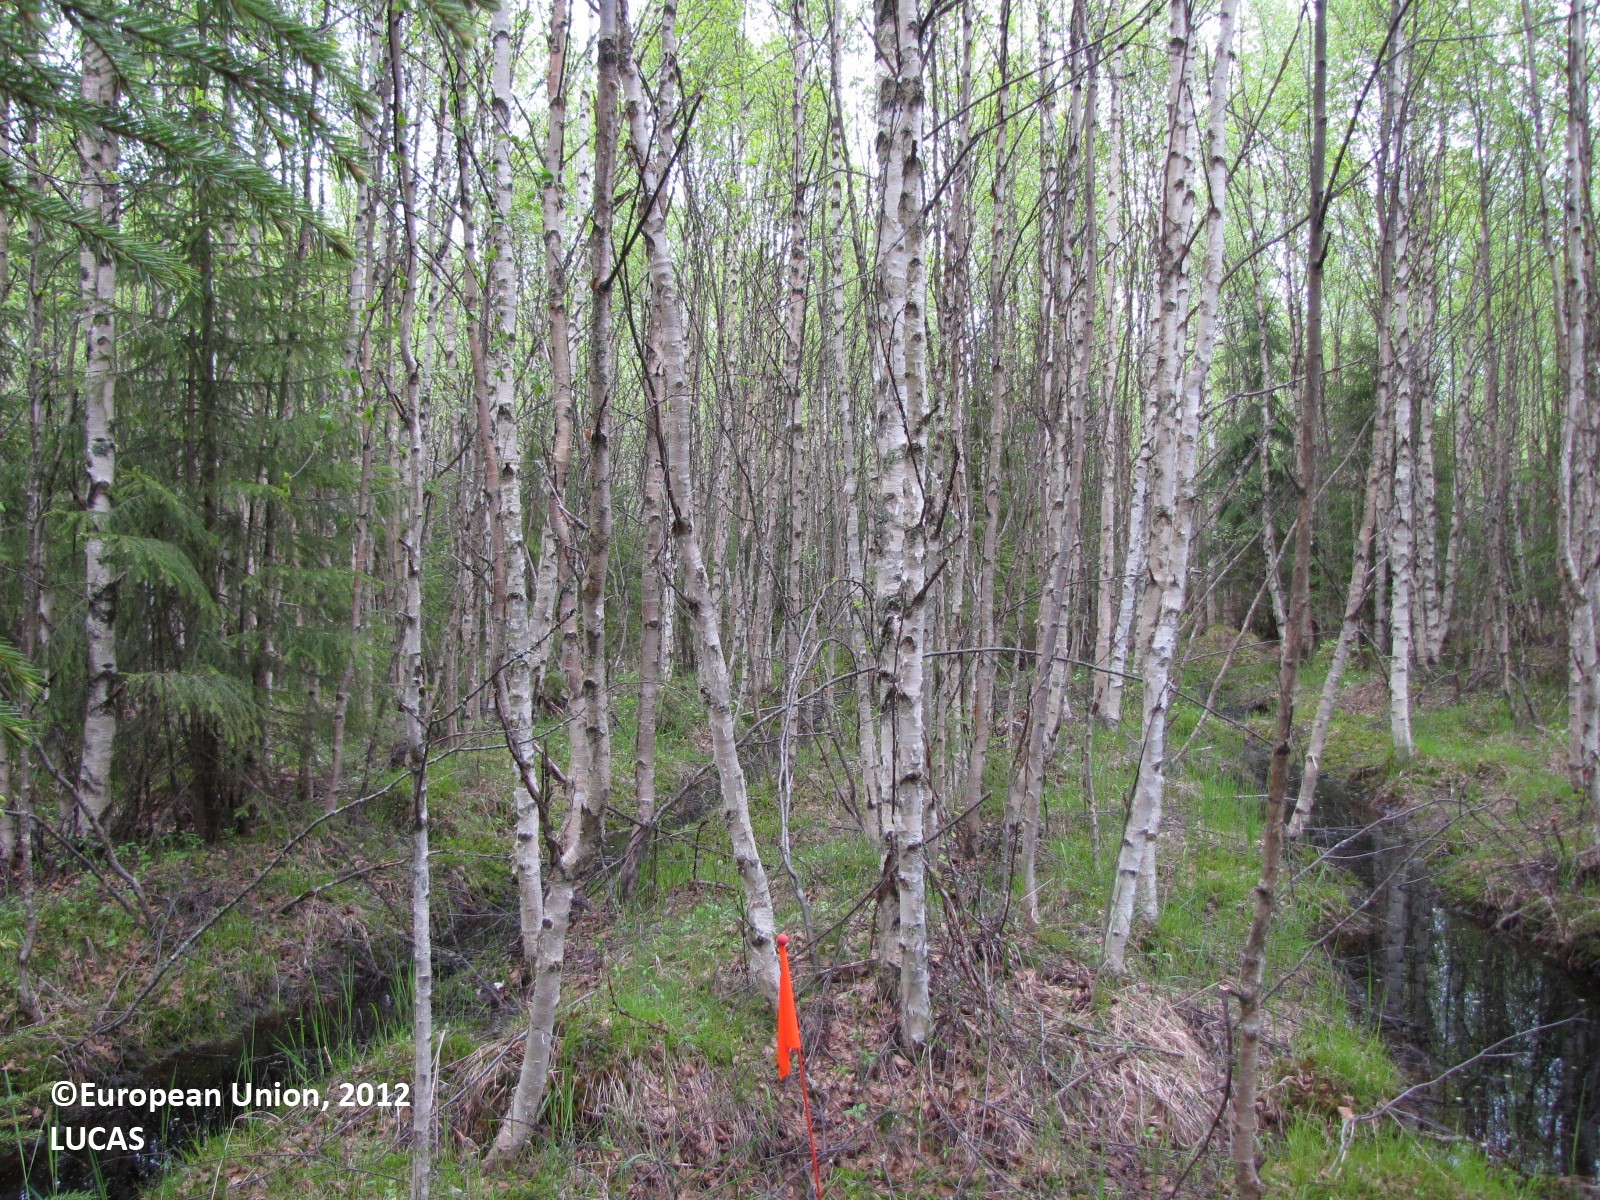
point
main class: Woodland
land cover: Spruce dominated mixed woodland
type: boreal forest
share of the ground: 50 - 75 %
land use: Forestry
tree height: > 5 m
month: June
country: FI
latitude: 65.8462
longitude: 24.5305
